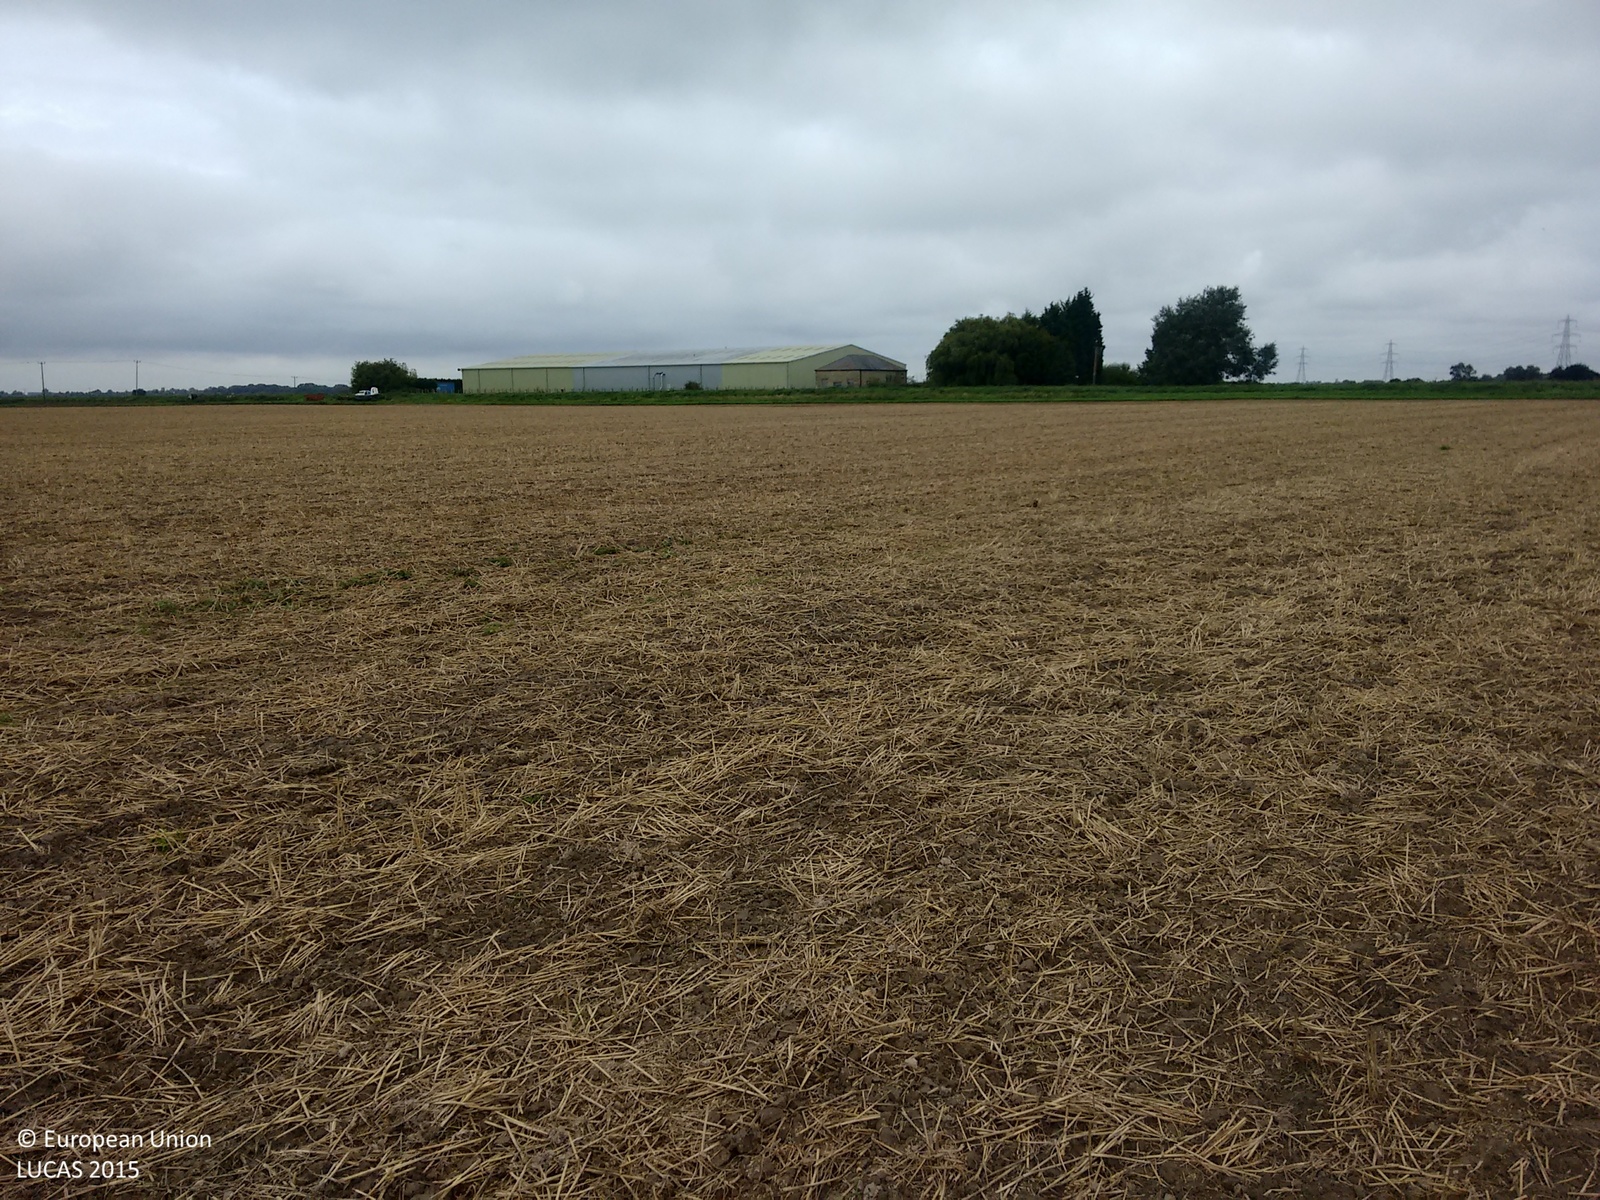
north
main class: Cropland
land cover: Common wheat
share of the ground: 25 - 50 %
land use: Agriculture (excluding fallow land and kitchen gardens)
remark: Harvested field
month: September
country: GB
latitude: 52.2880
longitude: 0.3094
